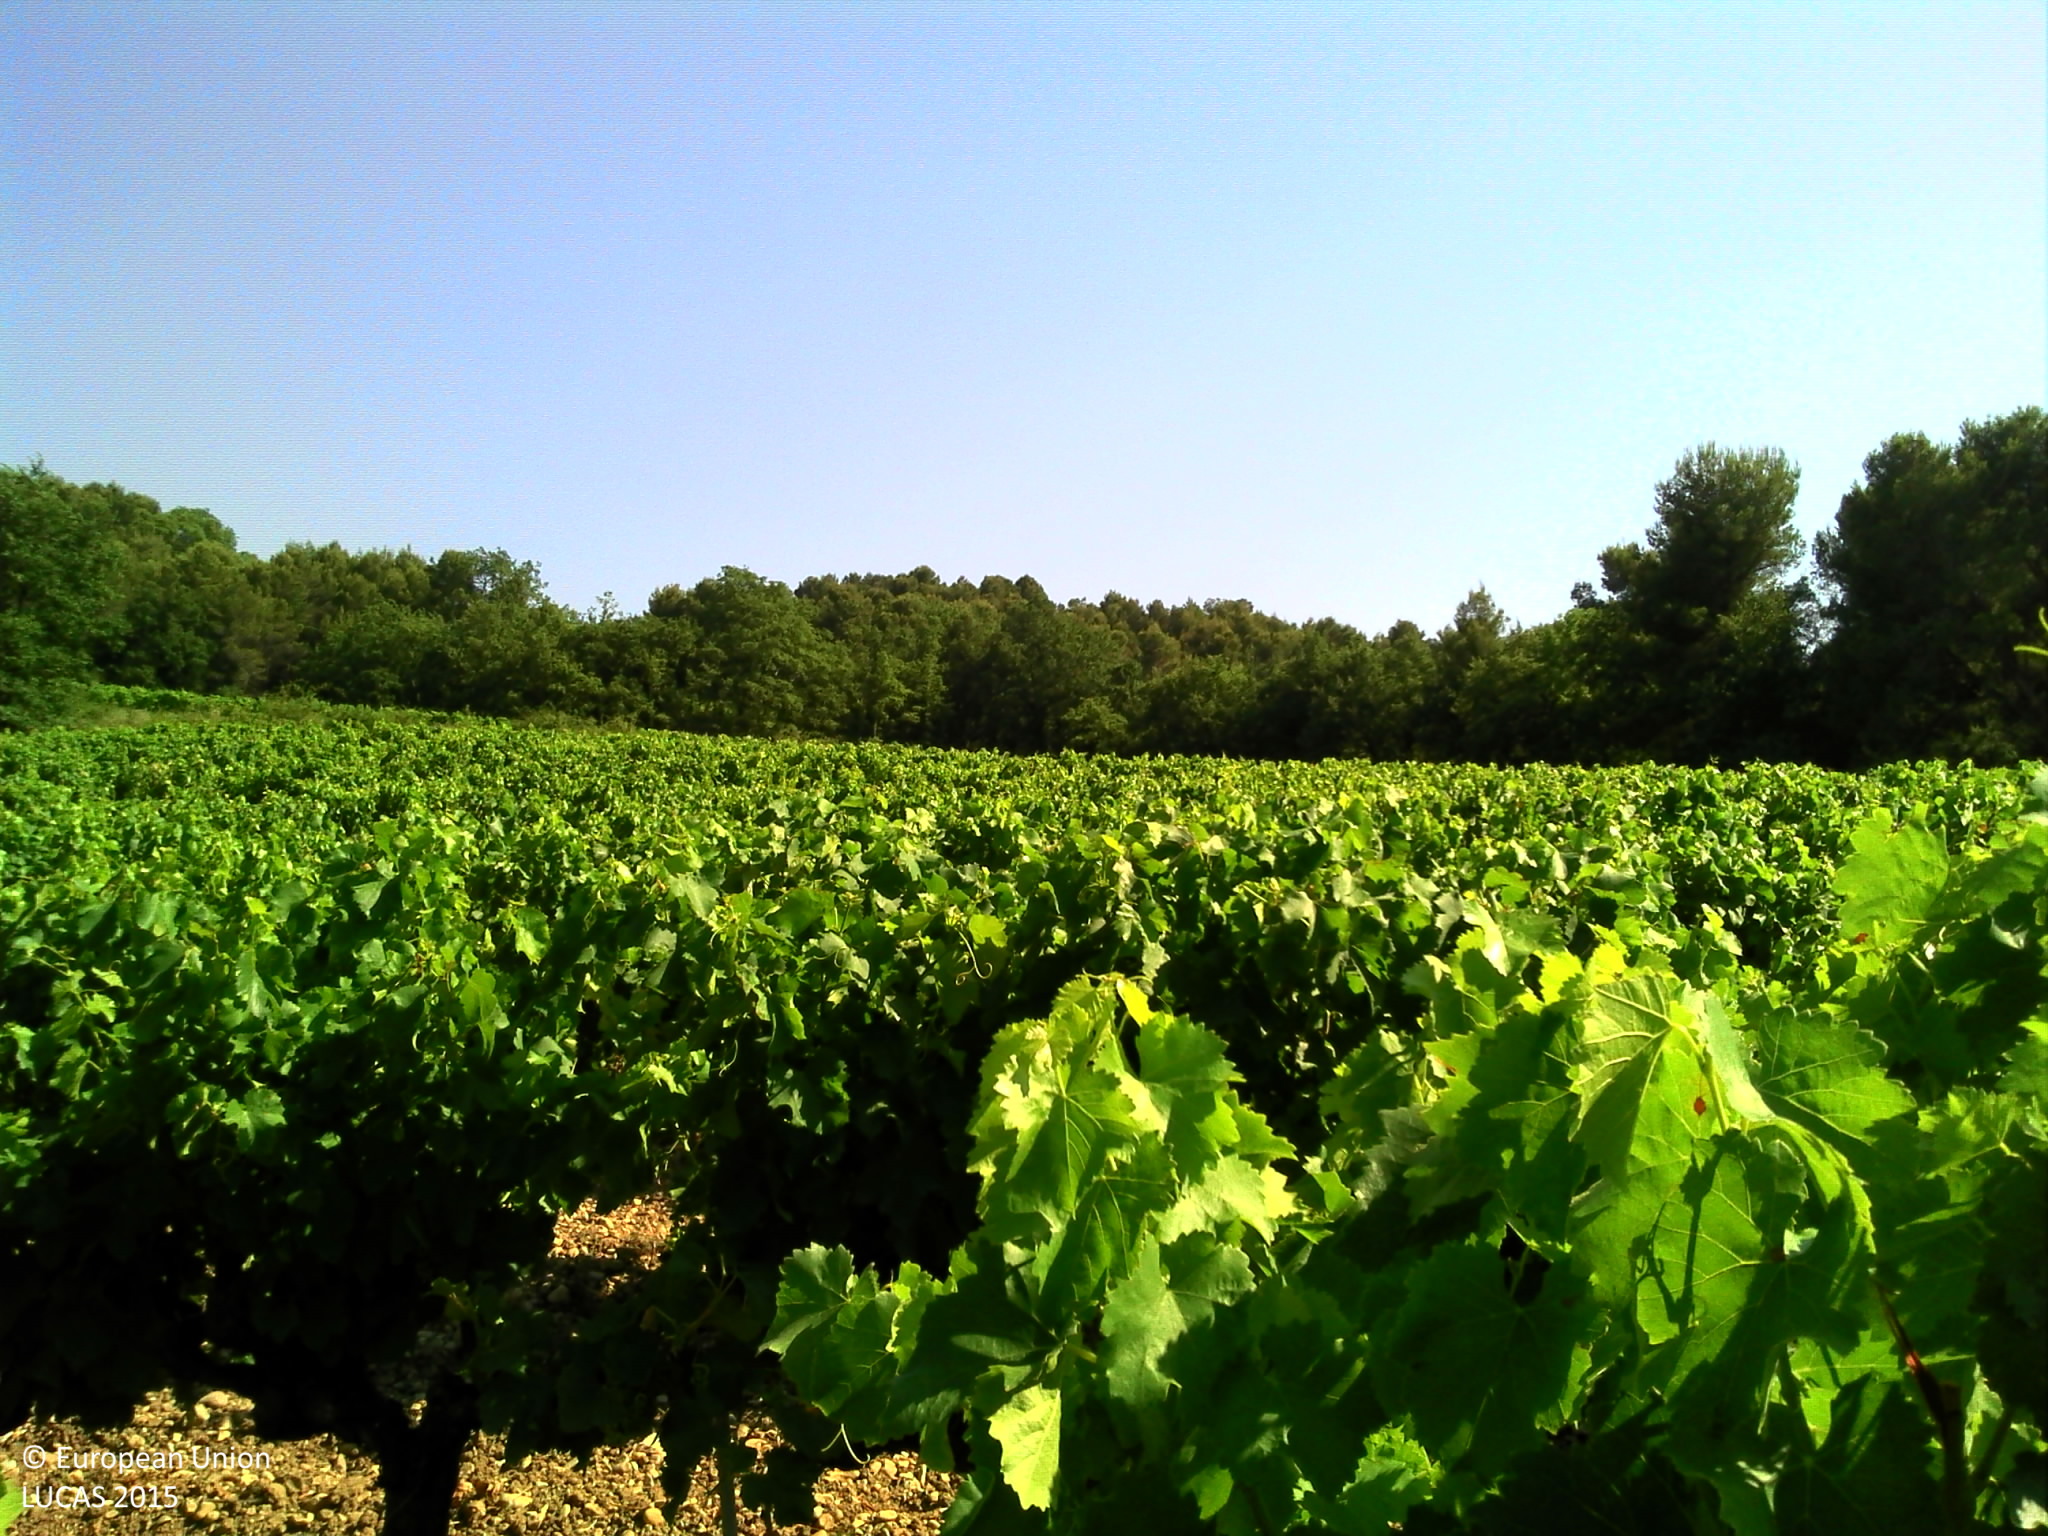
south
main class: Cropland
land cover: Vineyards
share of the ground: > 75 %
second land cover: Other bare soil
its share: > 75 %
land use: Agriculture (excluding fallow land and kitchen gardens)
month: June
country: FR
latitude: 44.2870
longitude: 5.0577
